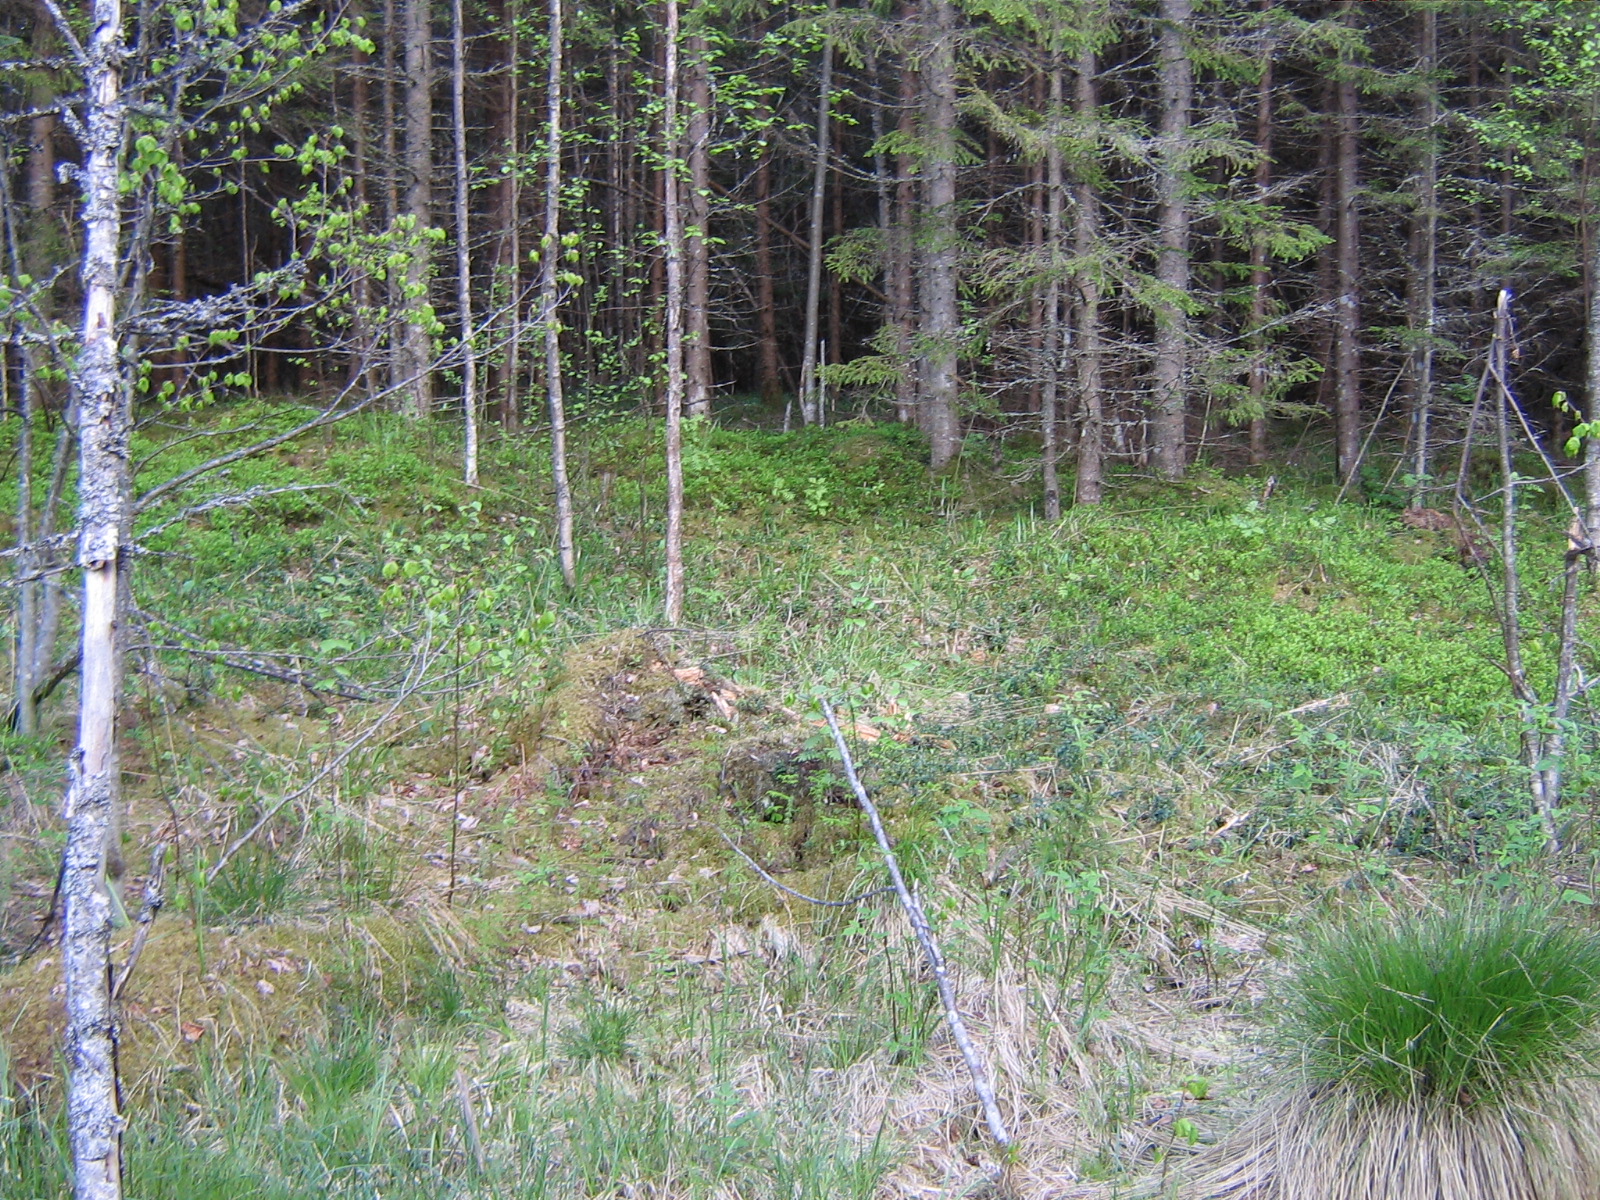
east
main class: Woodland
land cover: Broadleaved woodland
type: floodplain forest
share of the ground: 50 - 75 %
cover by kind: broadleaved forest trees 70 %, herbaceous plants 15 %, lichens and mosses 15 %
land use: Semi-natural and natural areas not in use
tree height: > 5 m
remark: Temporary flooded
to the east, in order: Broadleaved woodland; Spruce dominated coniferous woodland; Inland marshes; Spruce dominated coniferous woodland
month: May
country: LV
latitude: 57.3031
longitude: 25.8775
